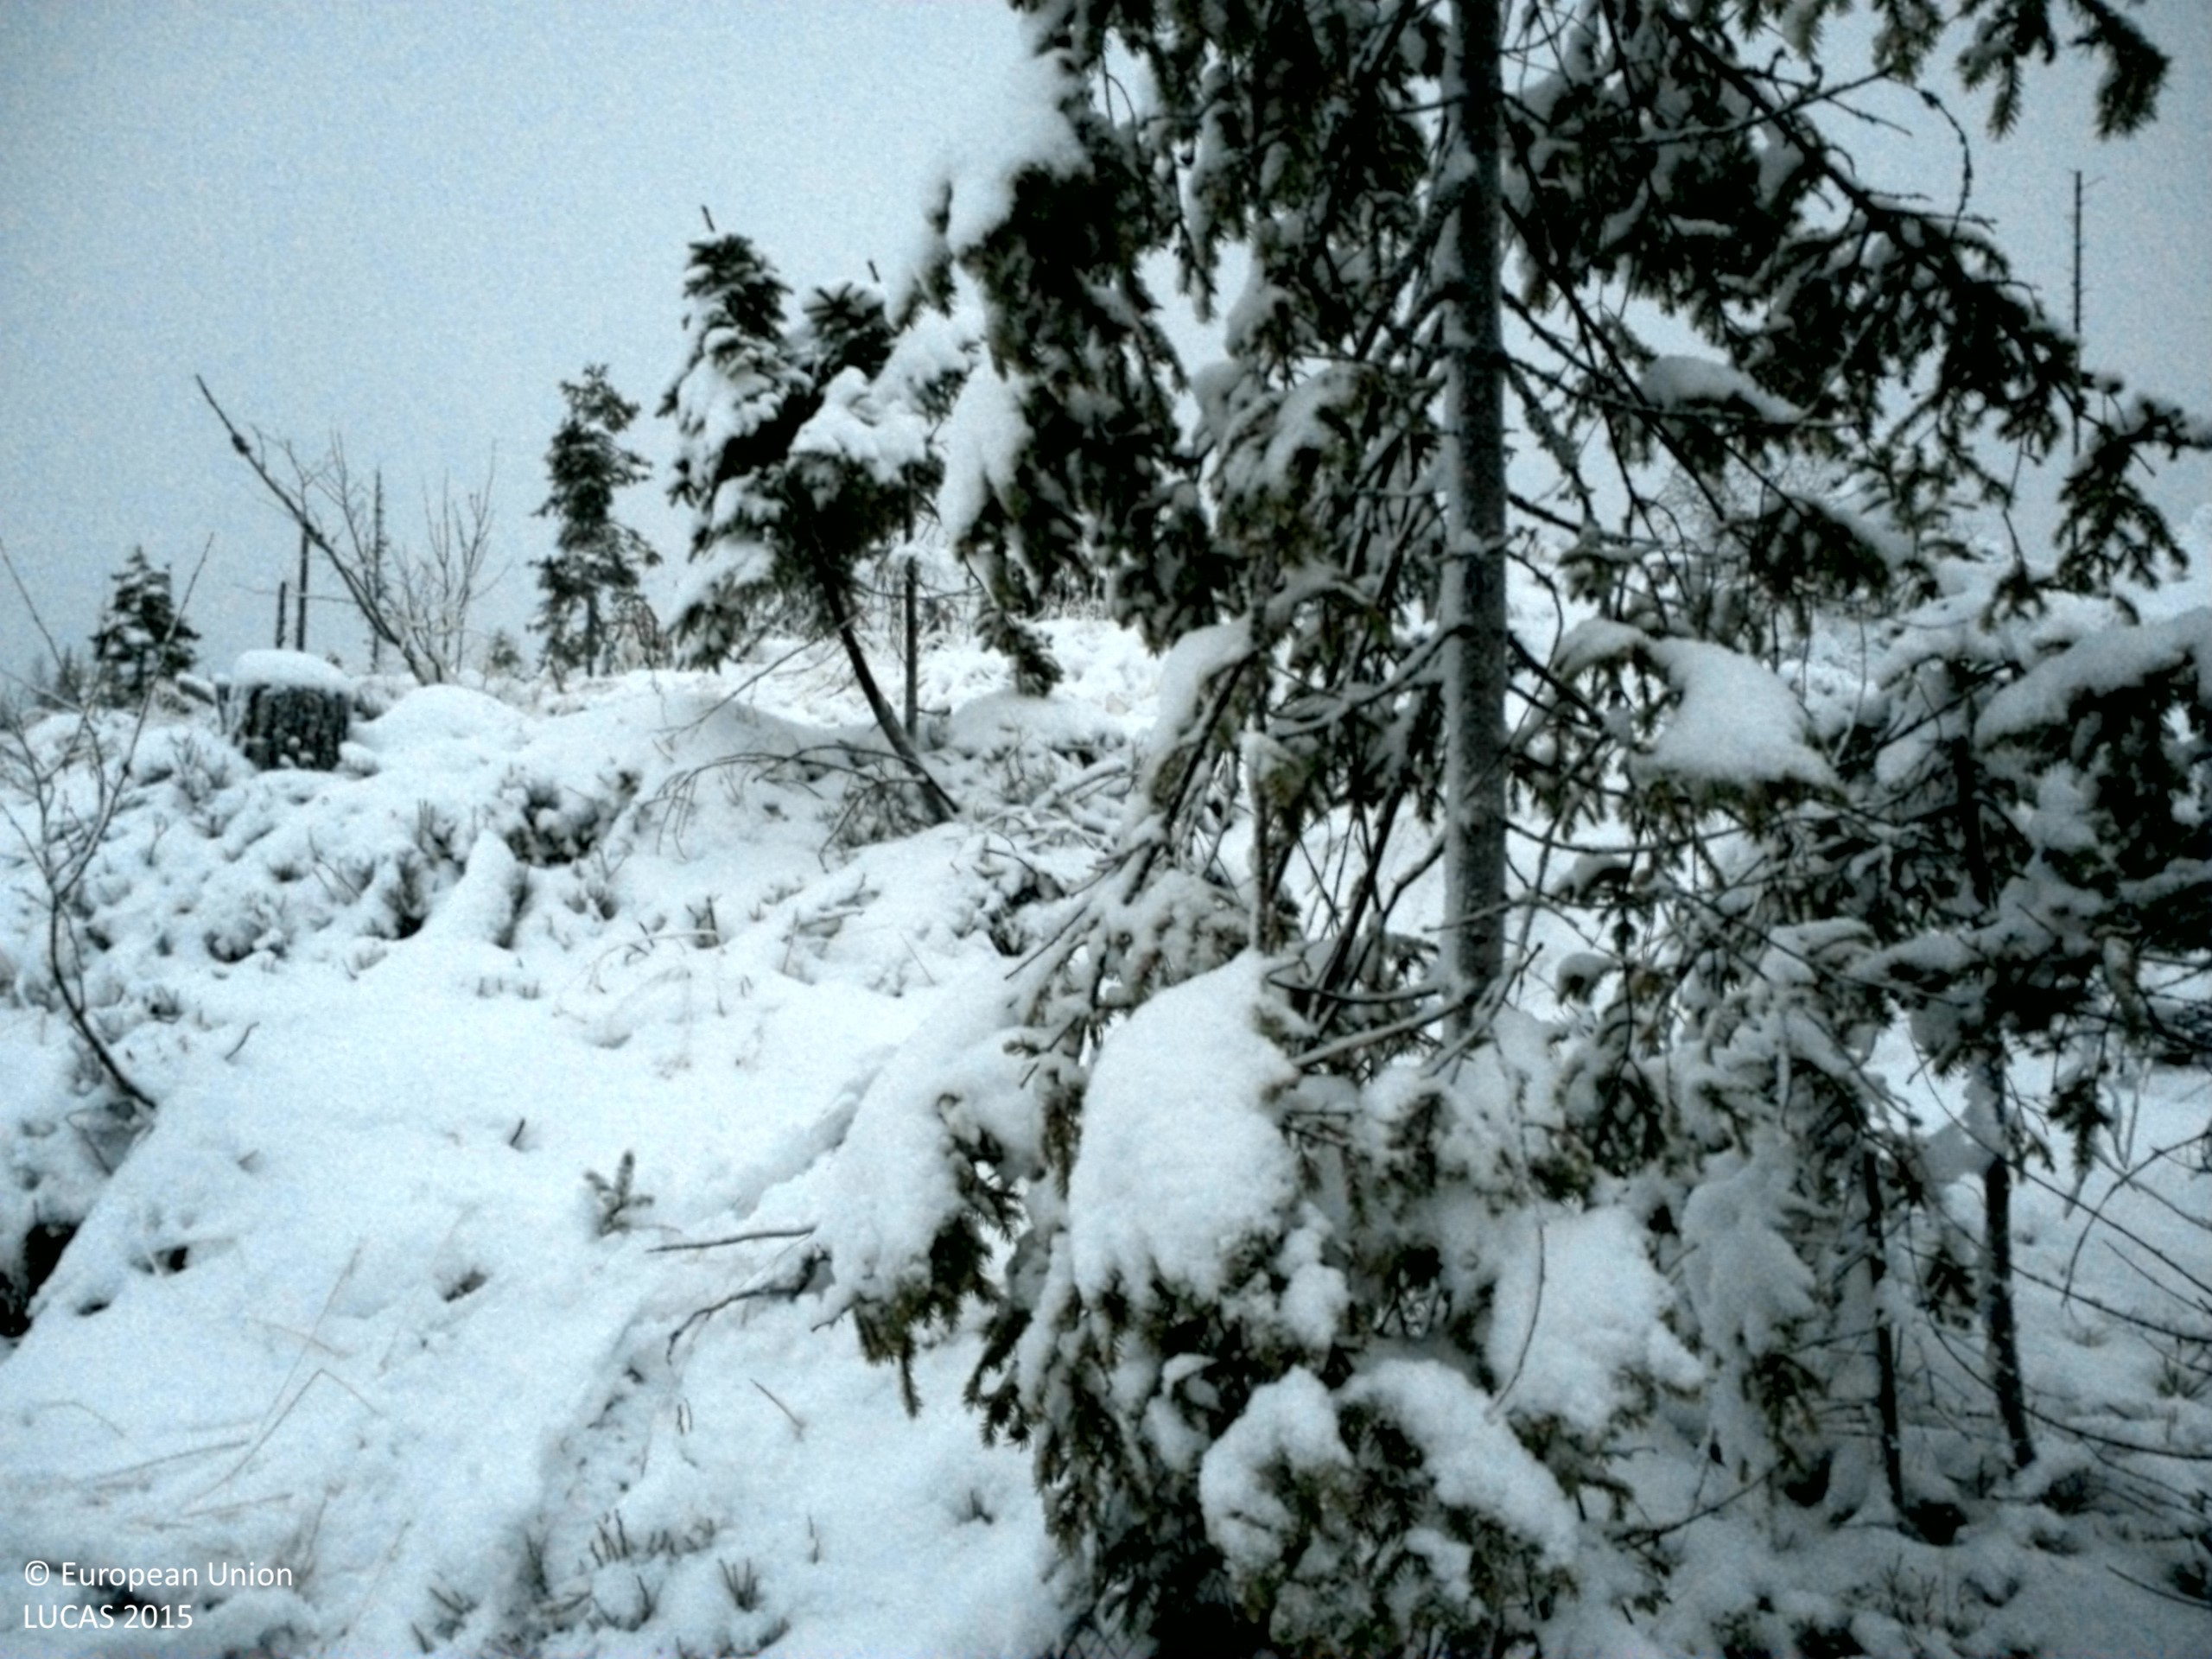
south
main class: Woodland
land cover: Spruce dominated mixed woodland
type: boreal forest
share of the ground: 10 - 25 %
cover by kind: herbaceous plants 55 %, lichens and mosses 20 %, coniferous forest trees 10 %, shrubs 10 %, broadleaved forest trees 5 %
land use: Forestry
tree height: < 5 m
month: November
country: SE
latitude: 63.6700
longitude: 15.9752
